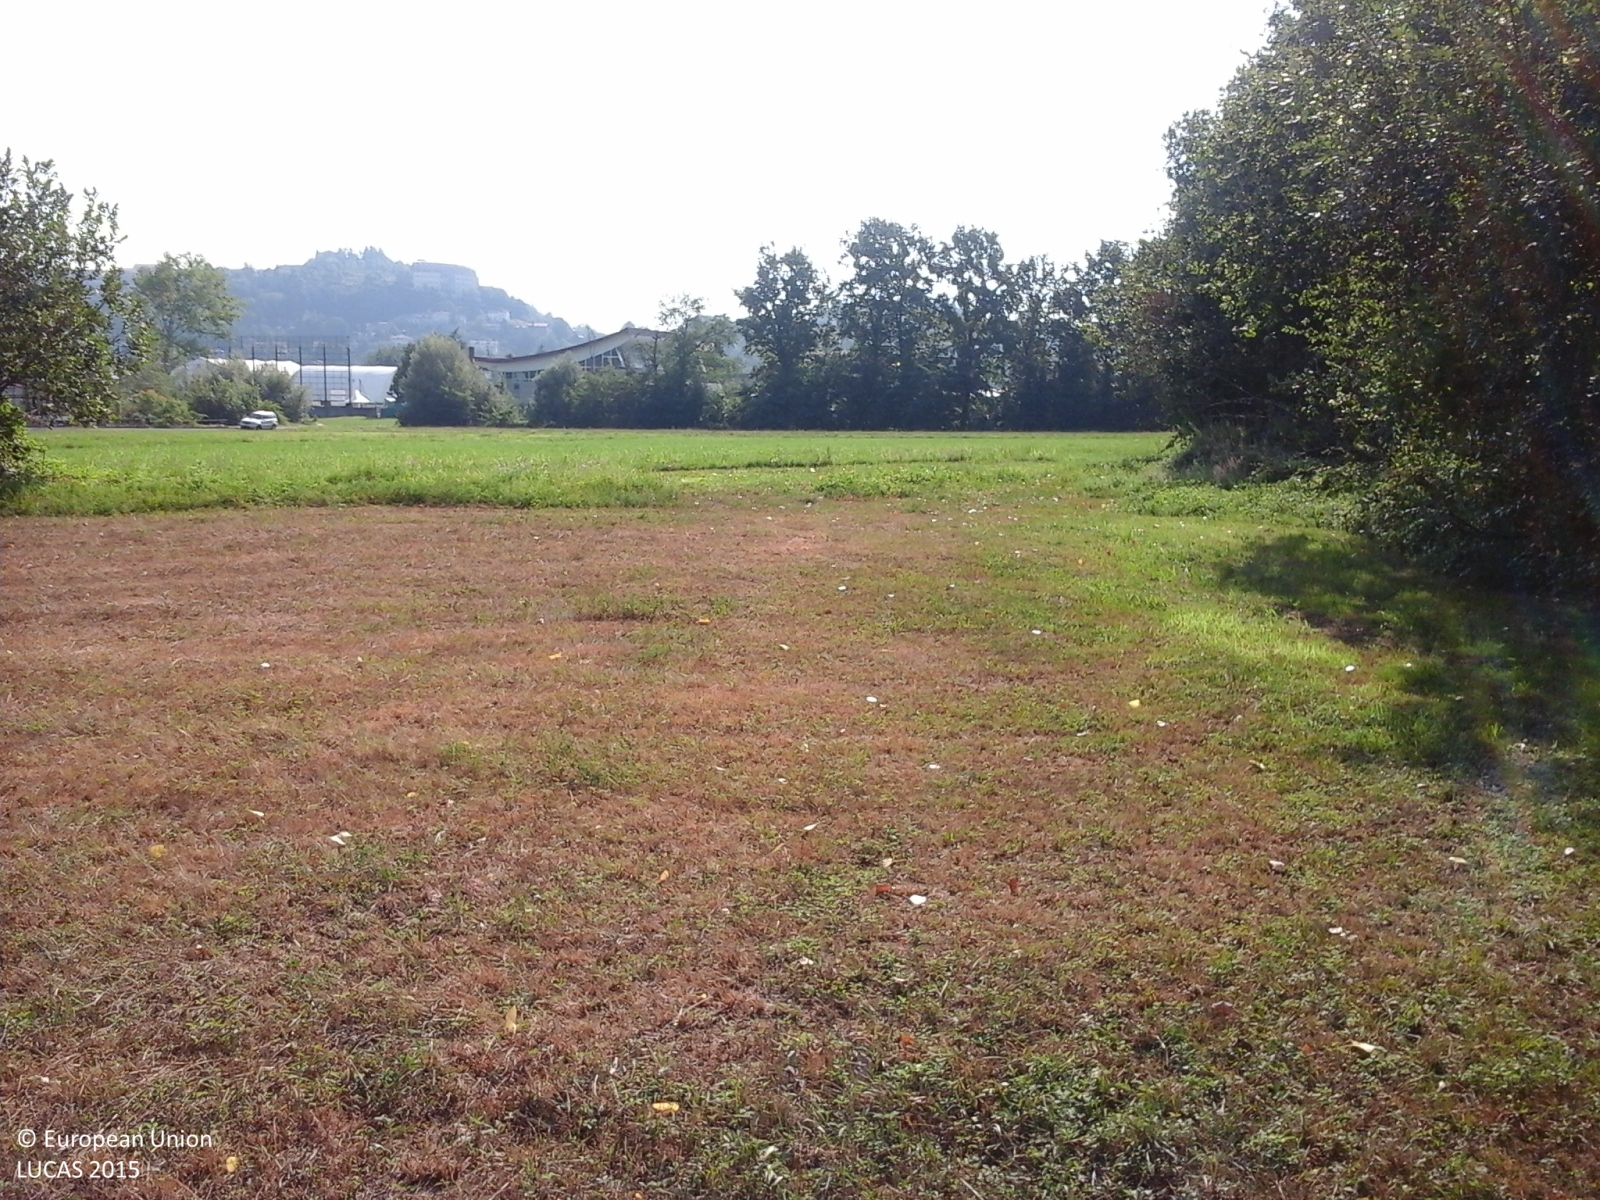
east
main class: Grassland
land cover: Grassland without tree/shrub cover
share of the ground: > 75 %
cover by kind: herbaceous plants 100 %
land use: Agriculture (excluding fallow land and kitchen gardens)
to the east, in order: Grassland without tree/shrub cover; Ditches and canals; Grassland without tree/shrub cover; Ditches and canals; Grassland without tree/shrub cover; Ditches and canals; Grassland without tree/shrub cover; Broadleaved woodland; Ditches and canals; Broadleaved woodland; Grassland without tree/shrub cover
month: August
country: IT
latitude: 44.3815
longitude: 7.8082
